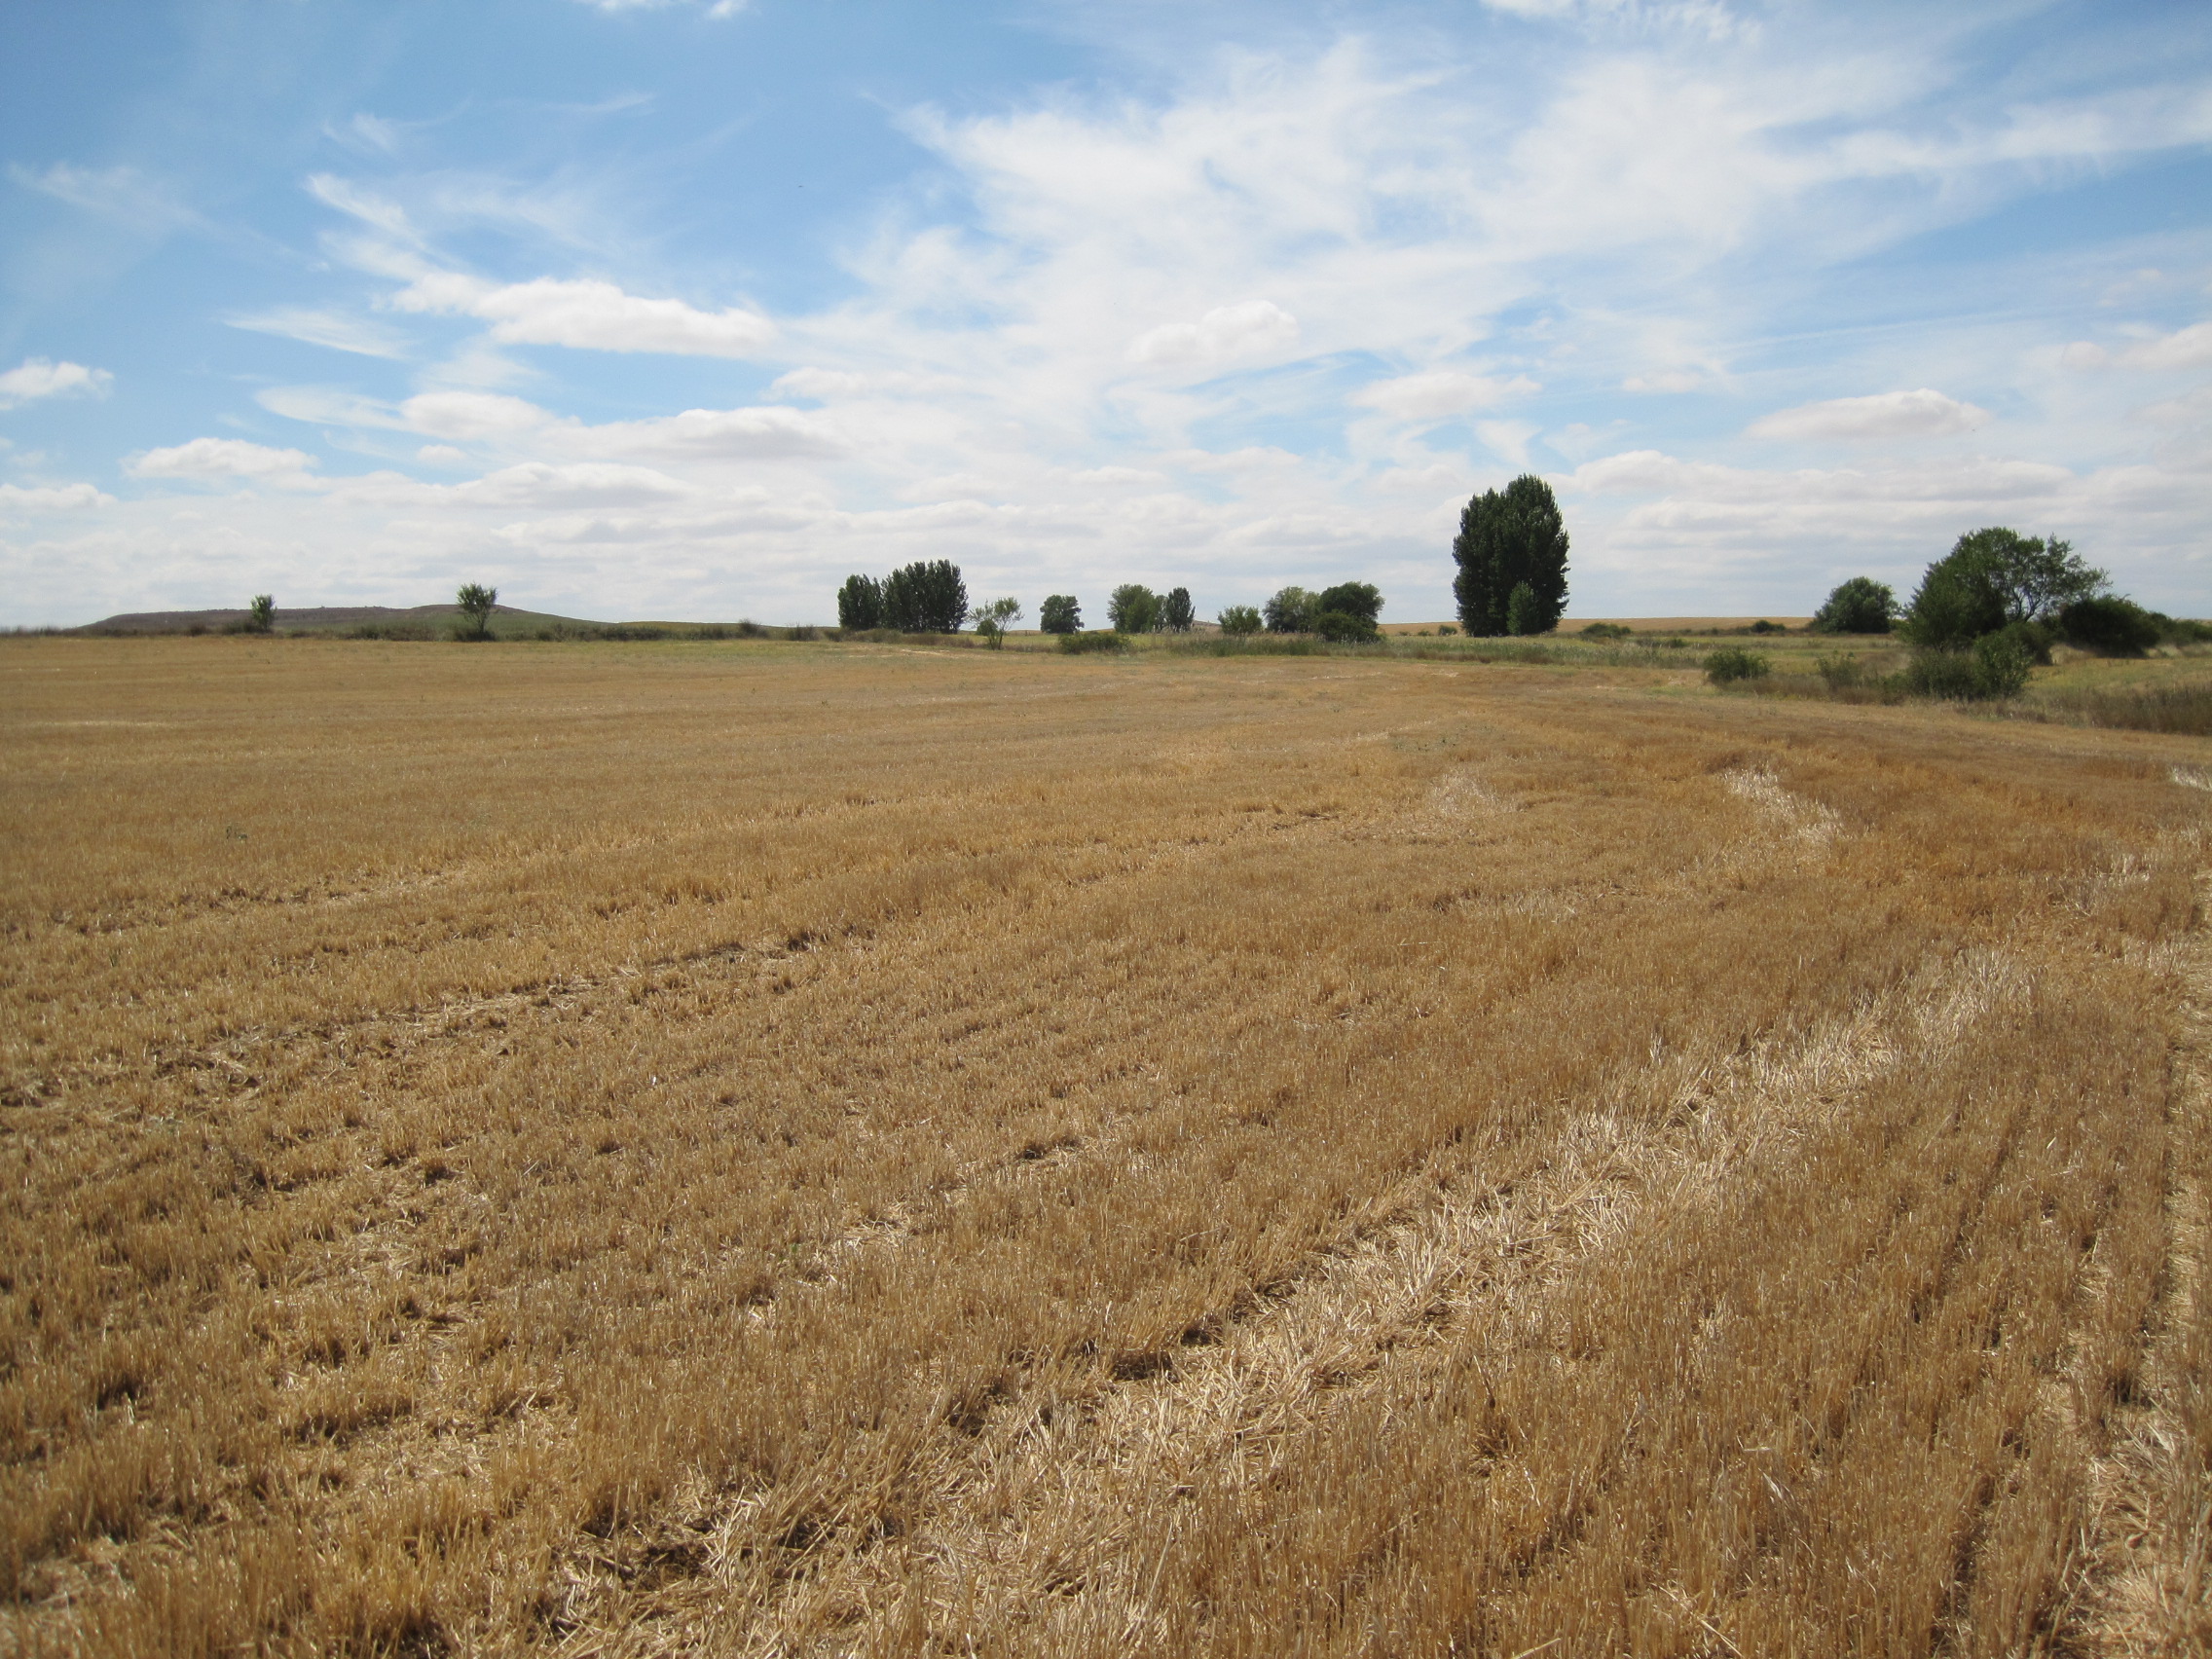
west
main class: Cropland
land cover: Barley
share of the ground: < 10 %
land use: Agriculture (excluding fallow land and kitchen gardens)
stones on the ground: < 10 %
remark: Harvested field
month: July
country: ES
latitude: 41.9932
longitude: -5.2079
